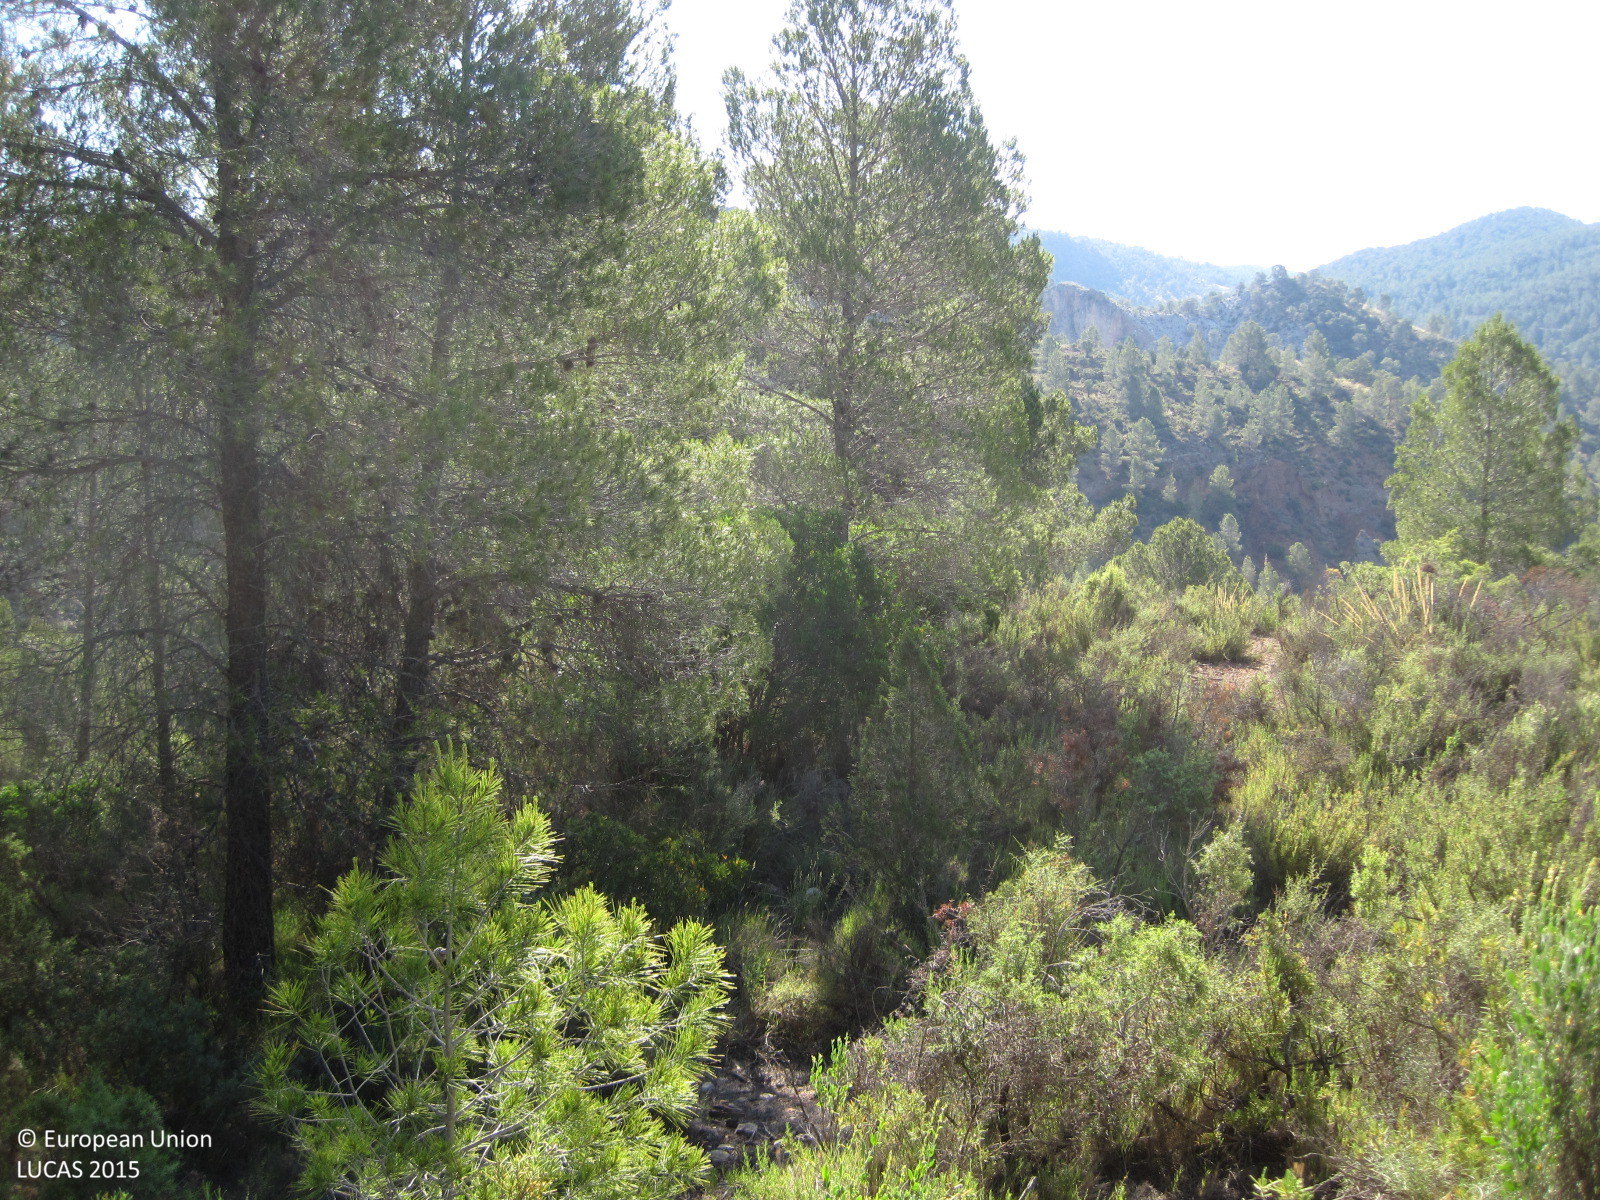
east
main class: Woodland
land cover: Pine dominated coniferous woodland
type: coniferous forest of the mediterranean region
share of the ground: 10 - 25 %
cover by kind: shrubs 40 %, coniferous forest trees 20 %, herbaceous plants 20 %, unconsolidated bare surface 20 %
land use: Semi-natural and natural areas not in use
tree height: > 5 m
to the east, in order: Pine dominated coniferous woodland; Rivers and streams; Pine dominated coniferous woodland
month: June
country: ES
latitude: 39.2561
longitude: -1.0655
